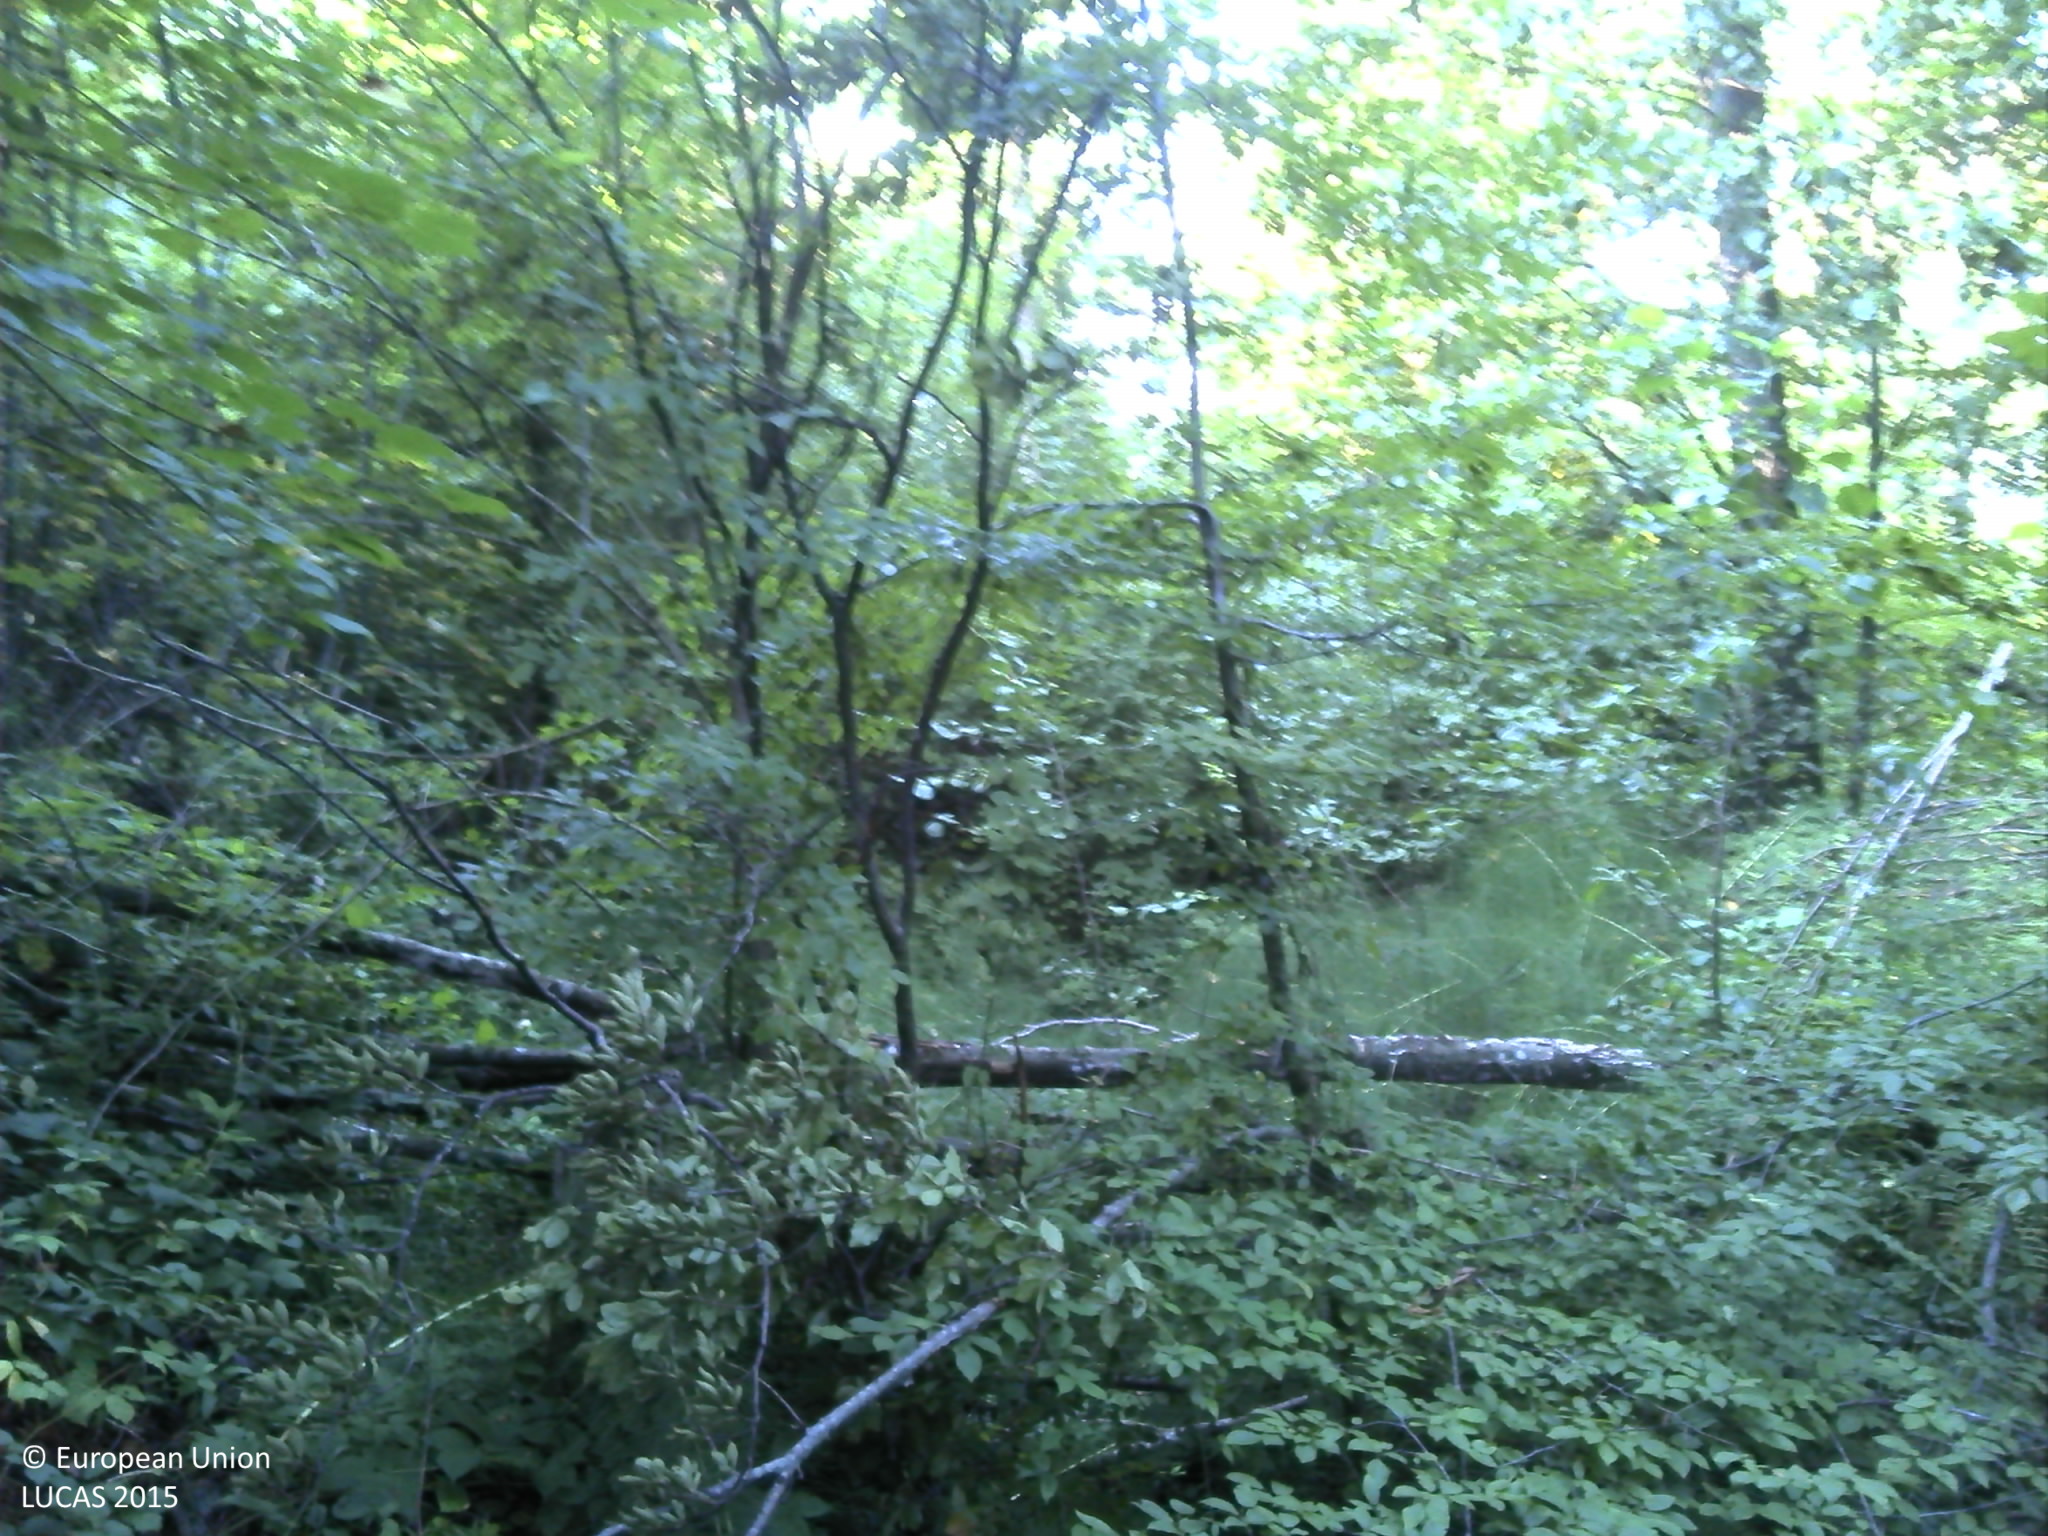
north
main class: Woodland
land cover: Broadleaved woodland
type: beech forest
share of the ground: > 75 %
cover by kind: broadleaved forest trees 100 %
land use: Forestry
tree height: > 5 m
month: August
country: HR
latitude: 45.3031
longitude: 16.5145
